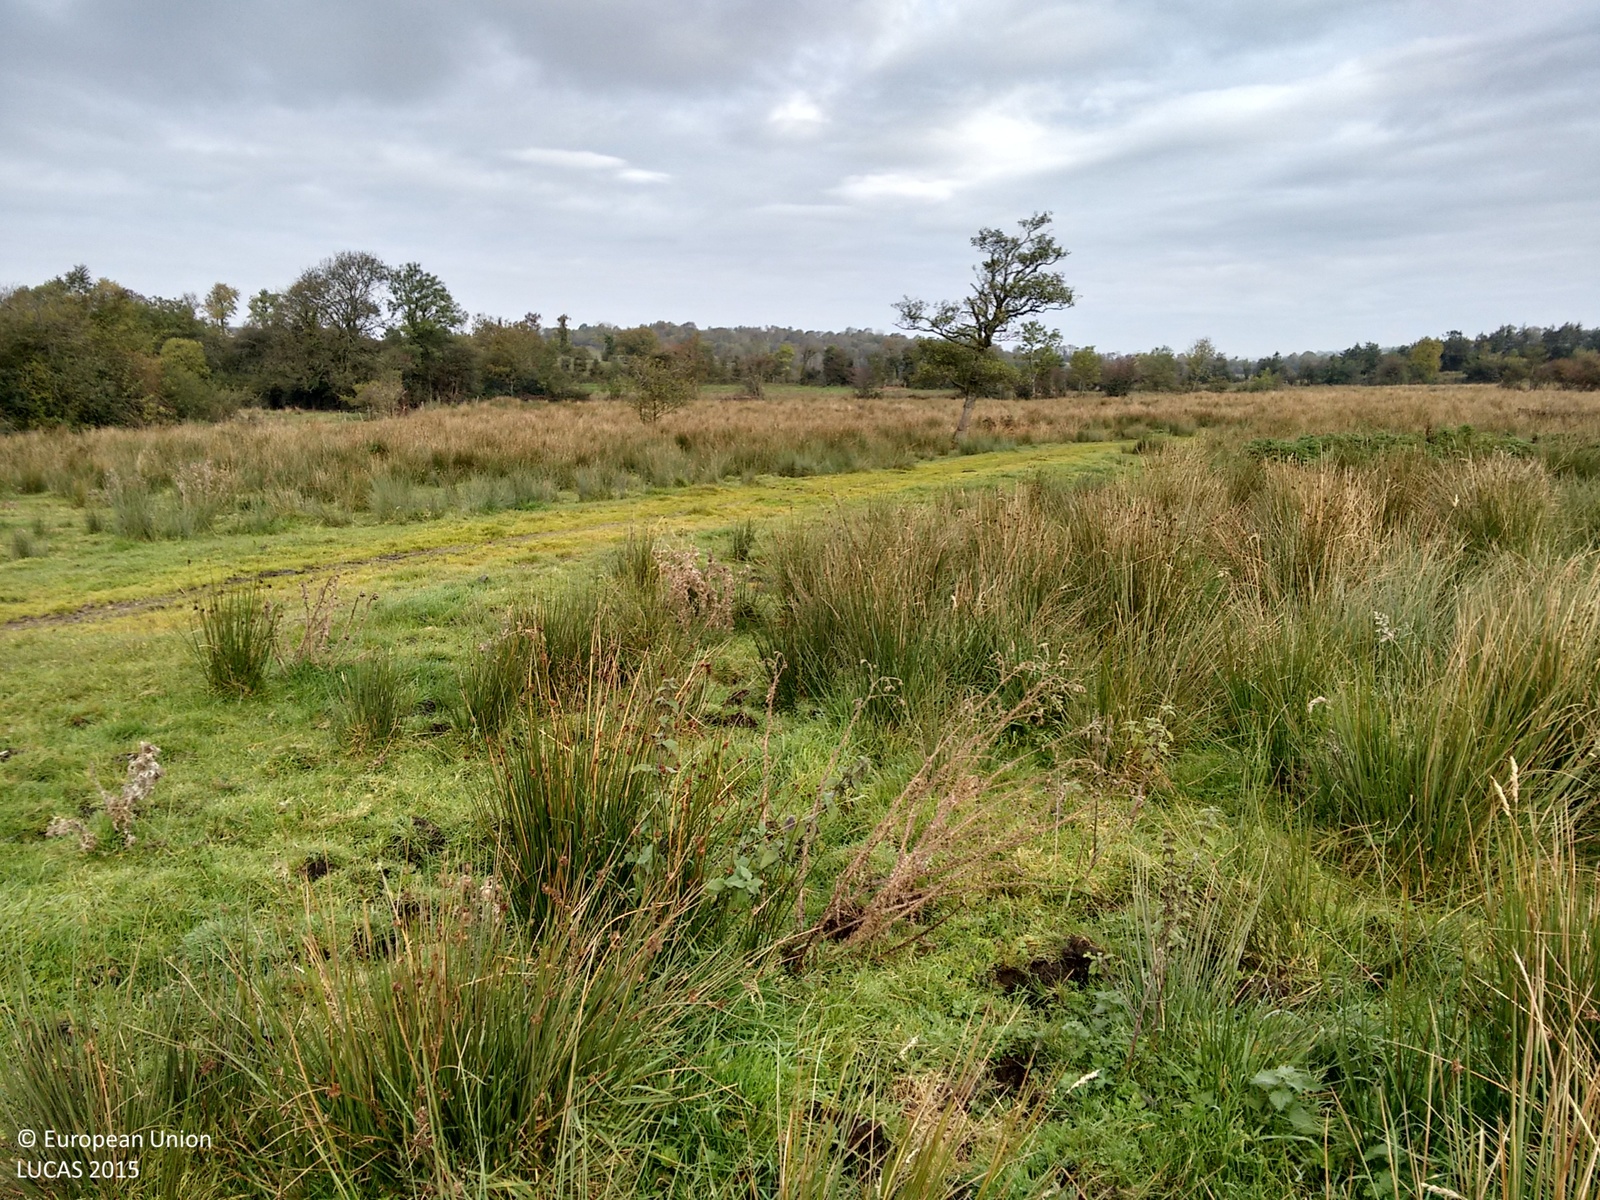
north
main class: Grassland
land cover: Grassland without tree/shrub cover
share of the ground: > 75 %
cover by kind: herbaceous plants 100 %
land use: Agriculture (excluding fallow land and kitchen gardens)
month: October
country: GB
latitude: 54.3571
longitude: -7.7848
